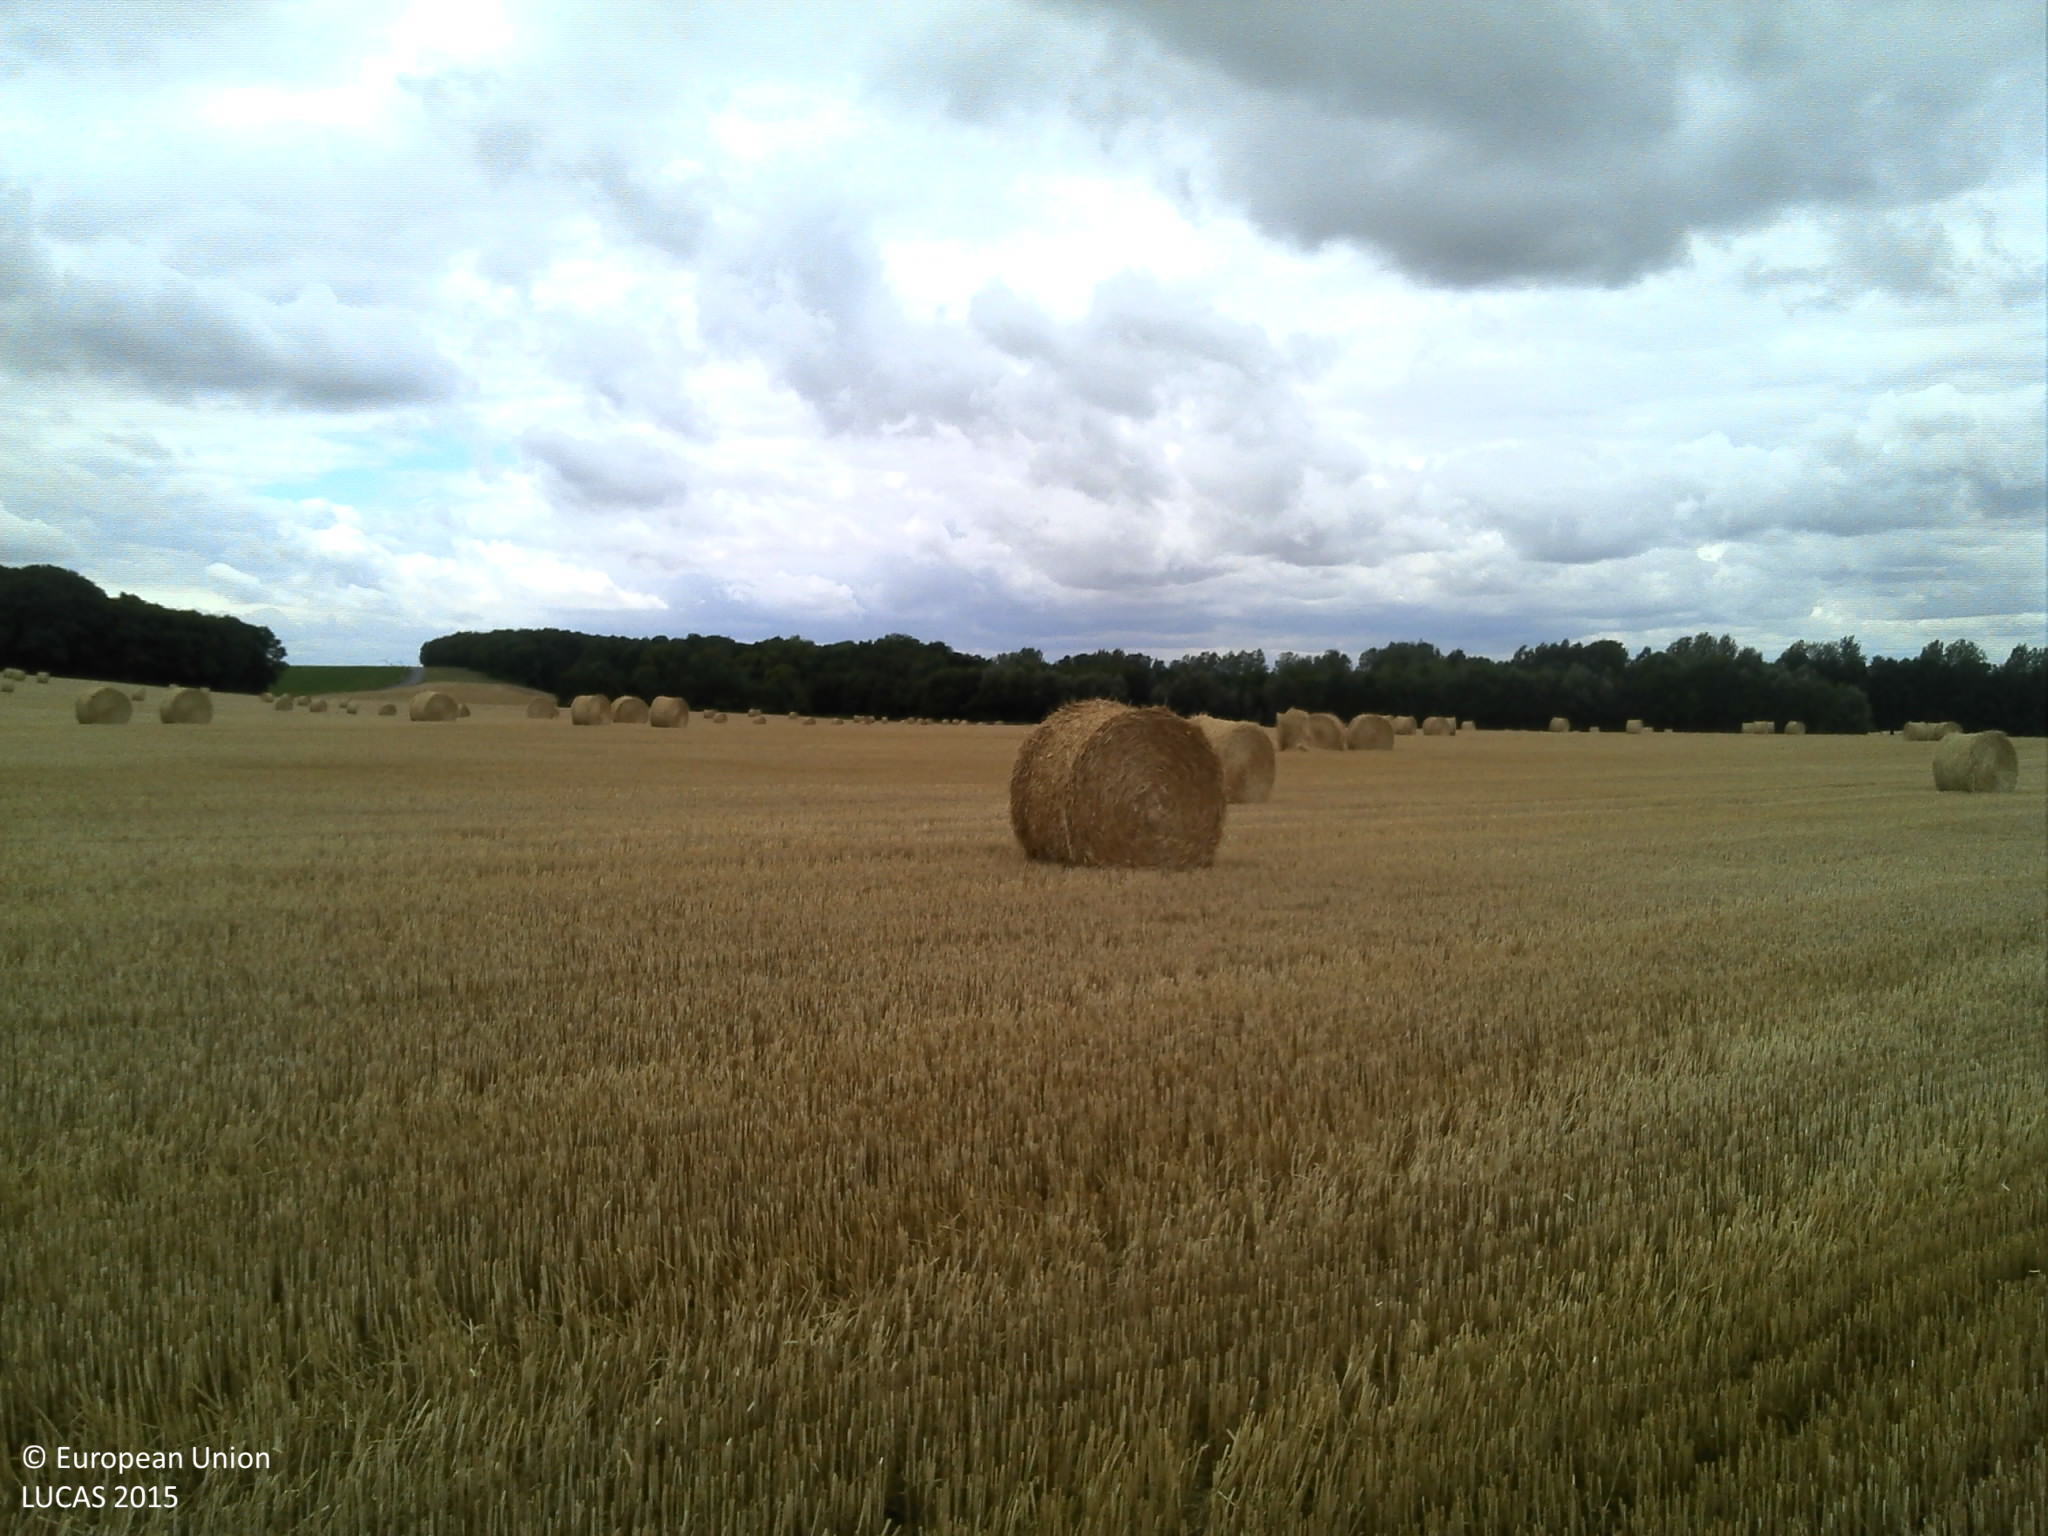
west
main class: Cropland
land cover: Common wheat
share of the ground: 50 - 75 %
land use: Agriculture (excluding fallow land and kitchen gardens)
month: July
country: FR
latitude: 49.4809
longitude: 4.6274
